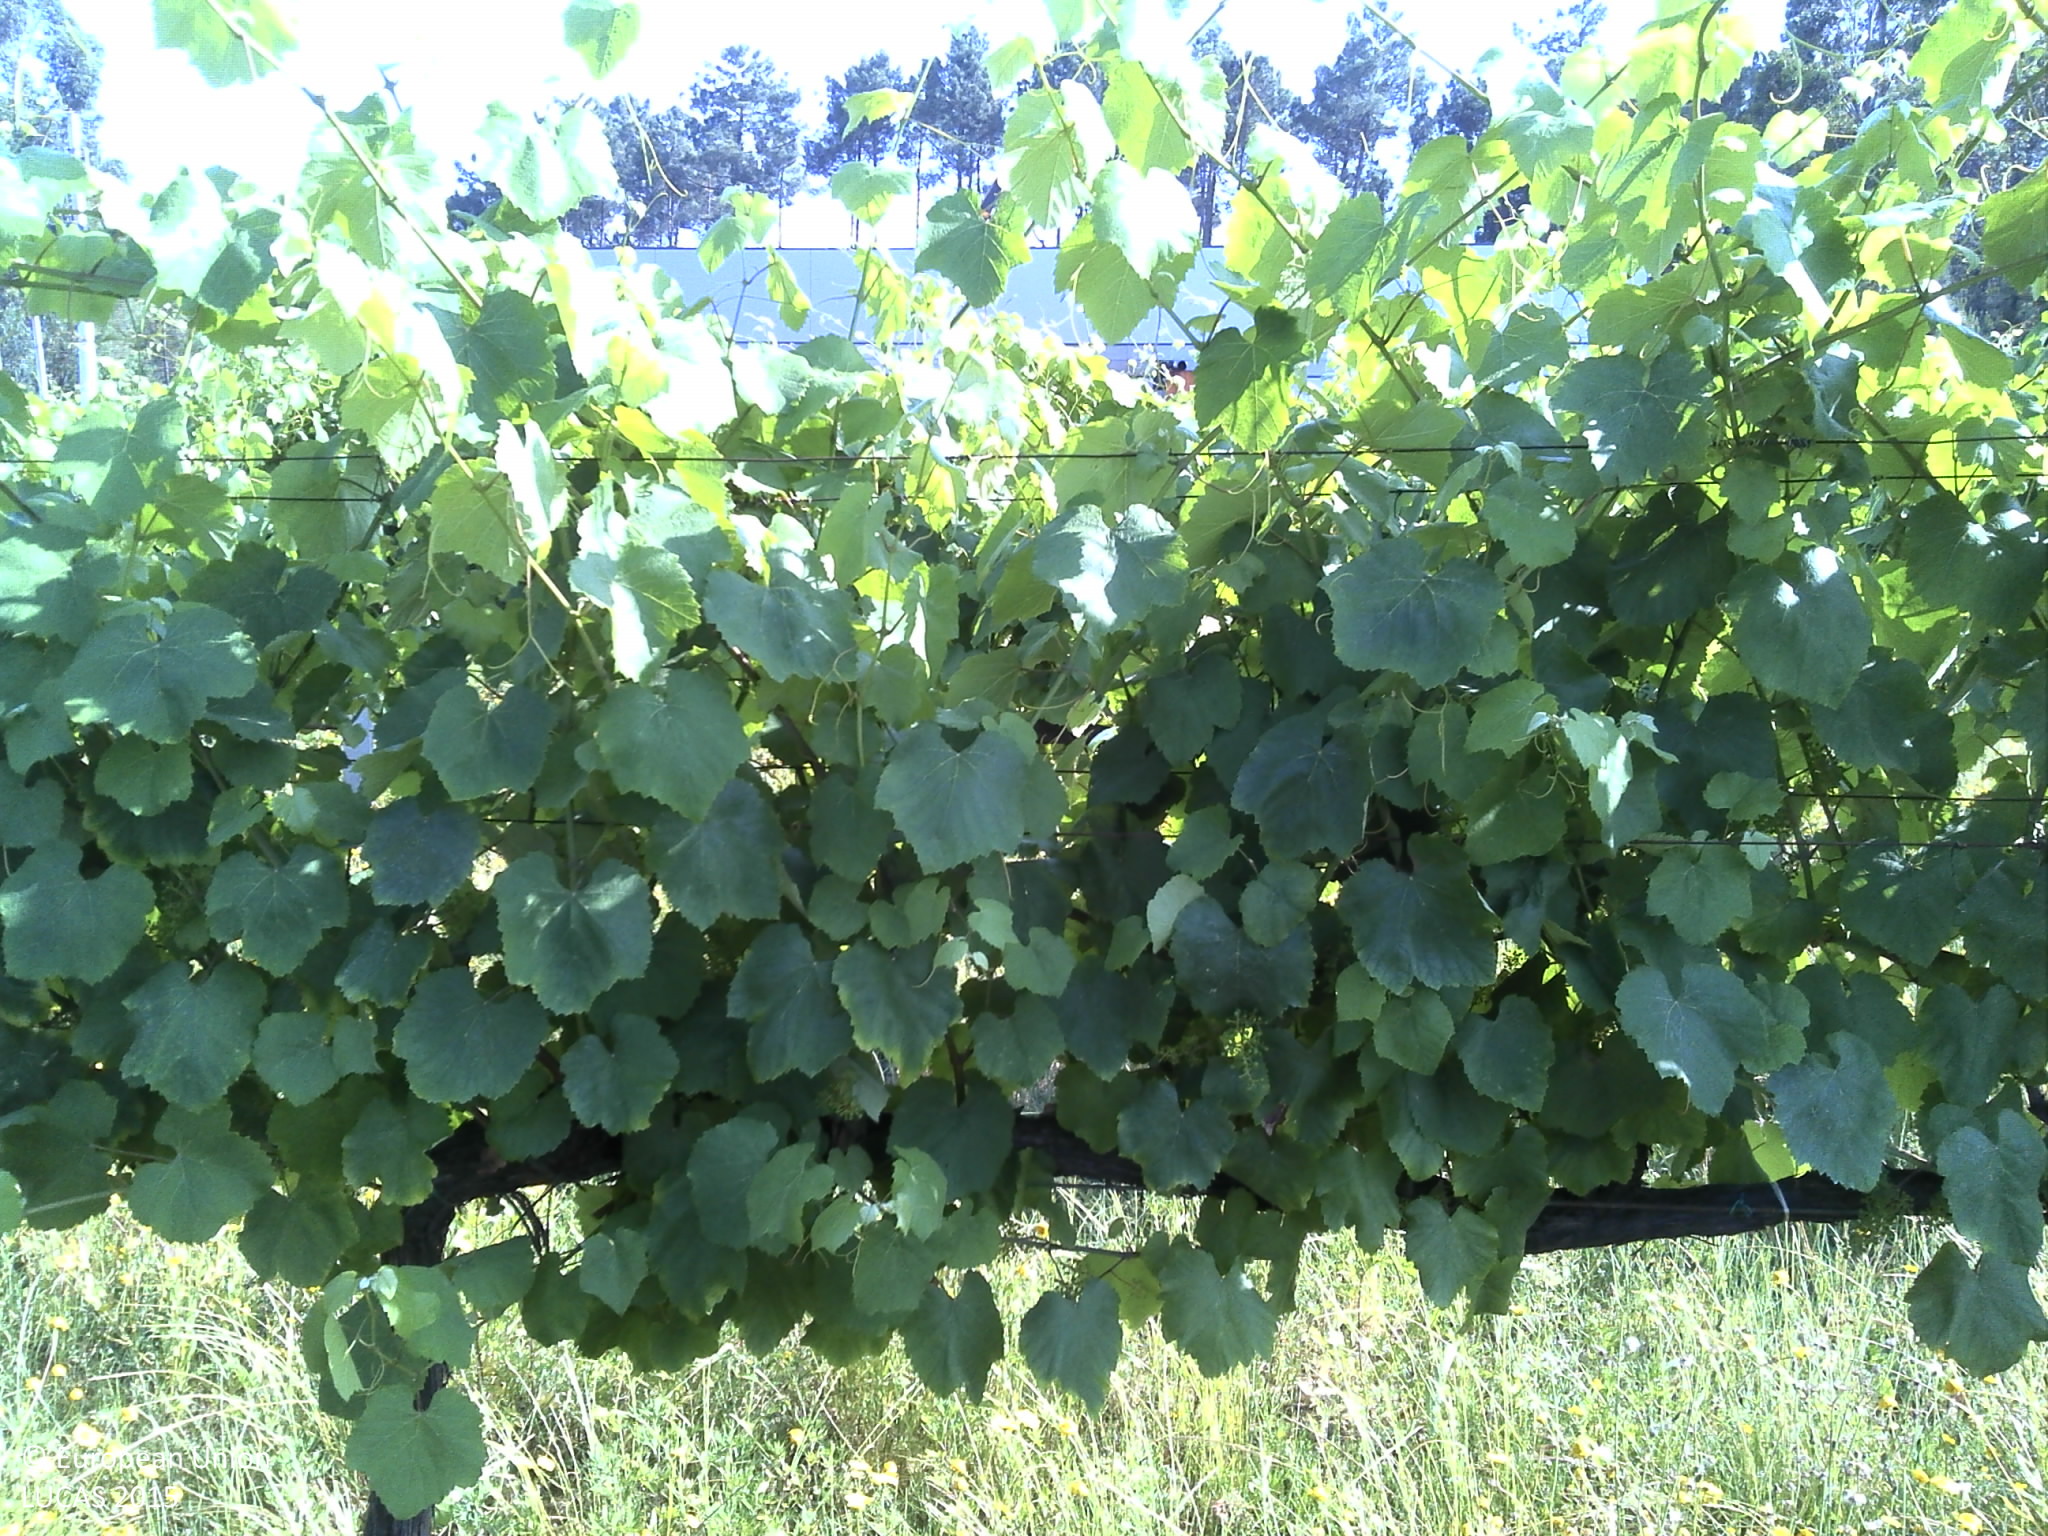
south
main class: Cropland
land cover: Vineyards
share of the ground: 10 - 25 %
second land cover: Grassland without tree/shrub cover
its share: 25 - 50 %
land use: Agriculture (excluding fallow land and kitchen gardens)
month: June
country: PT
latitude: 42.0689
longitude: -8.4488
